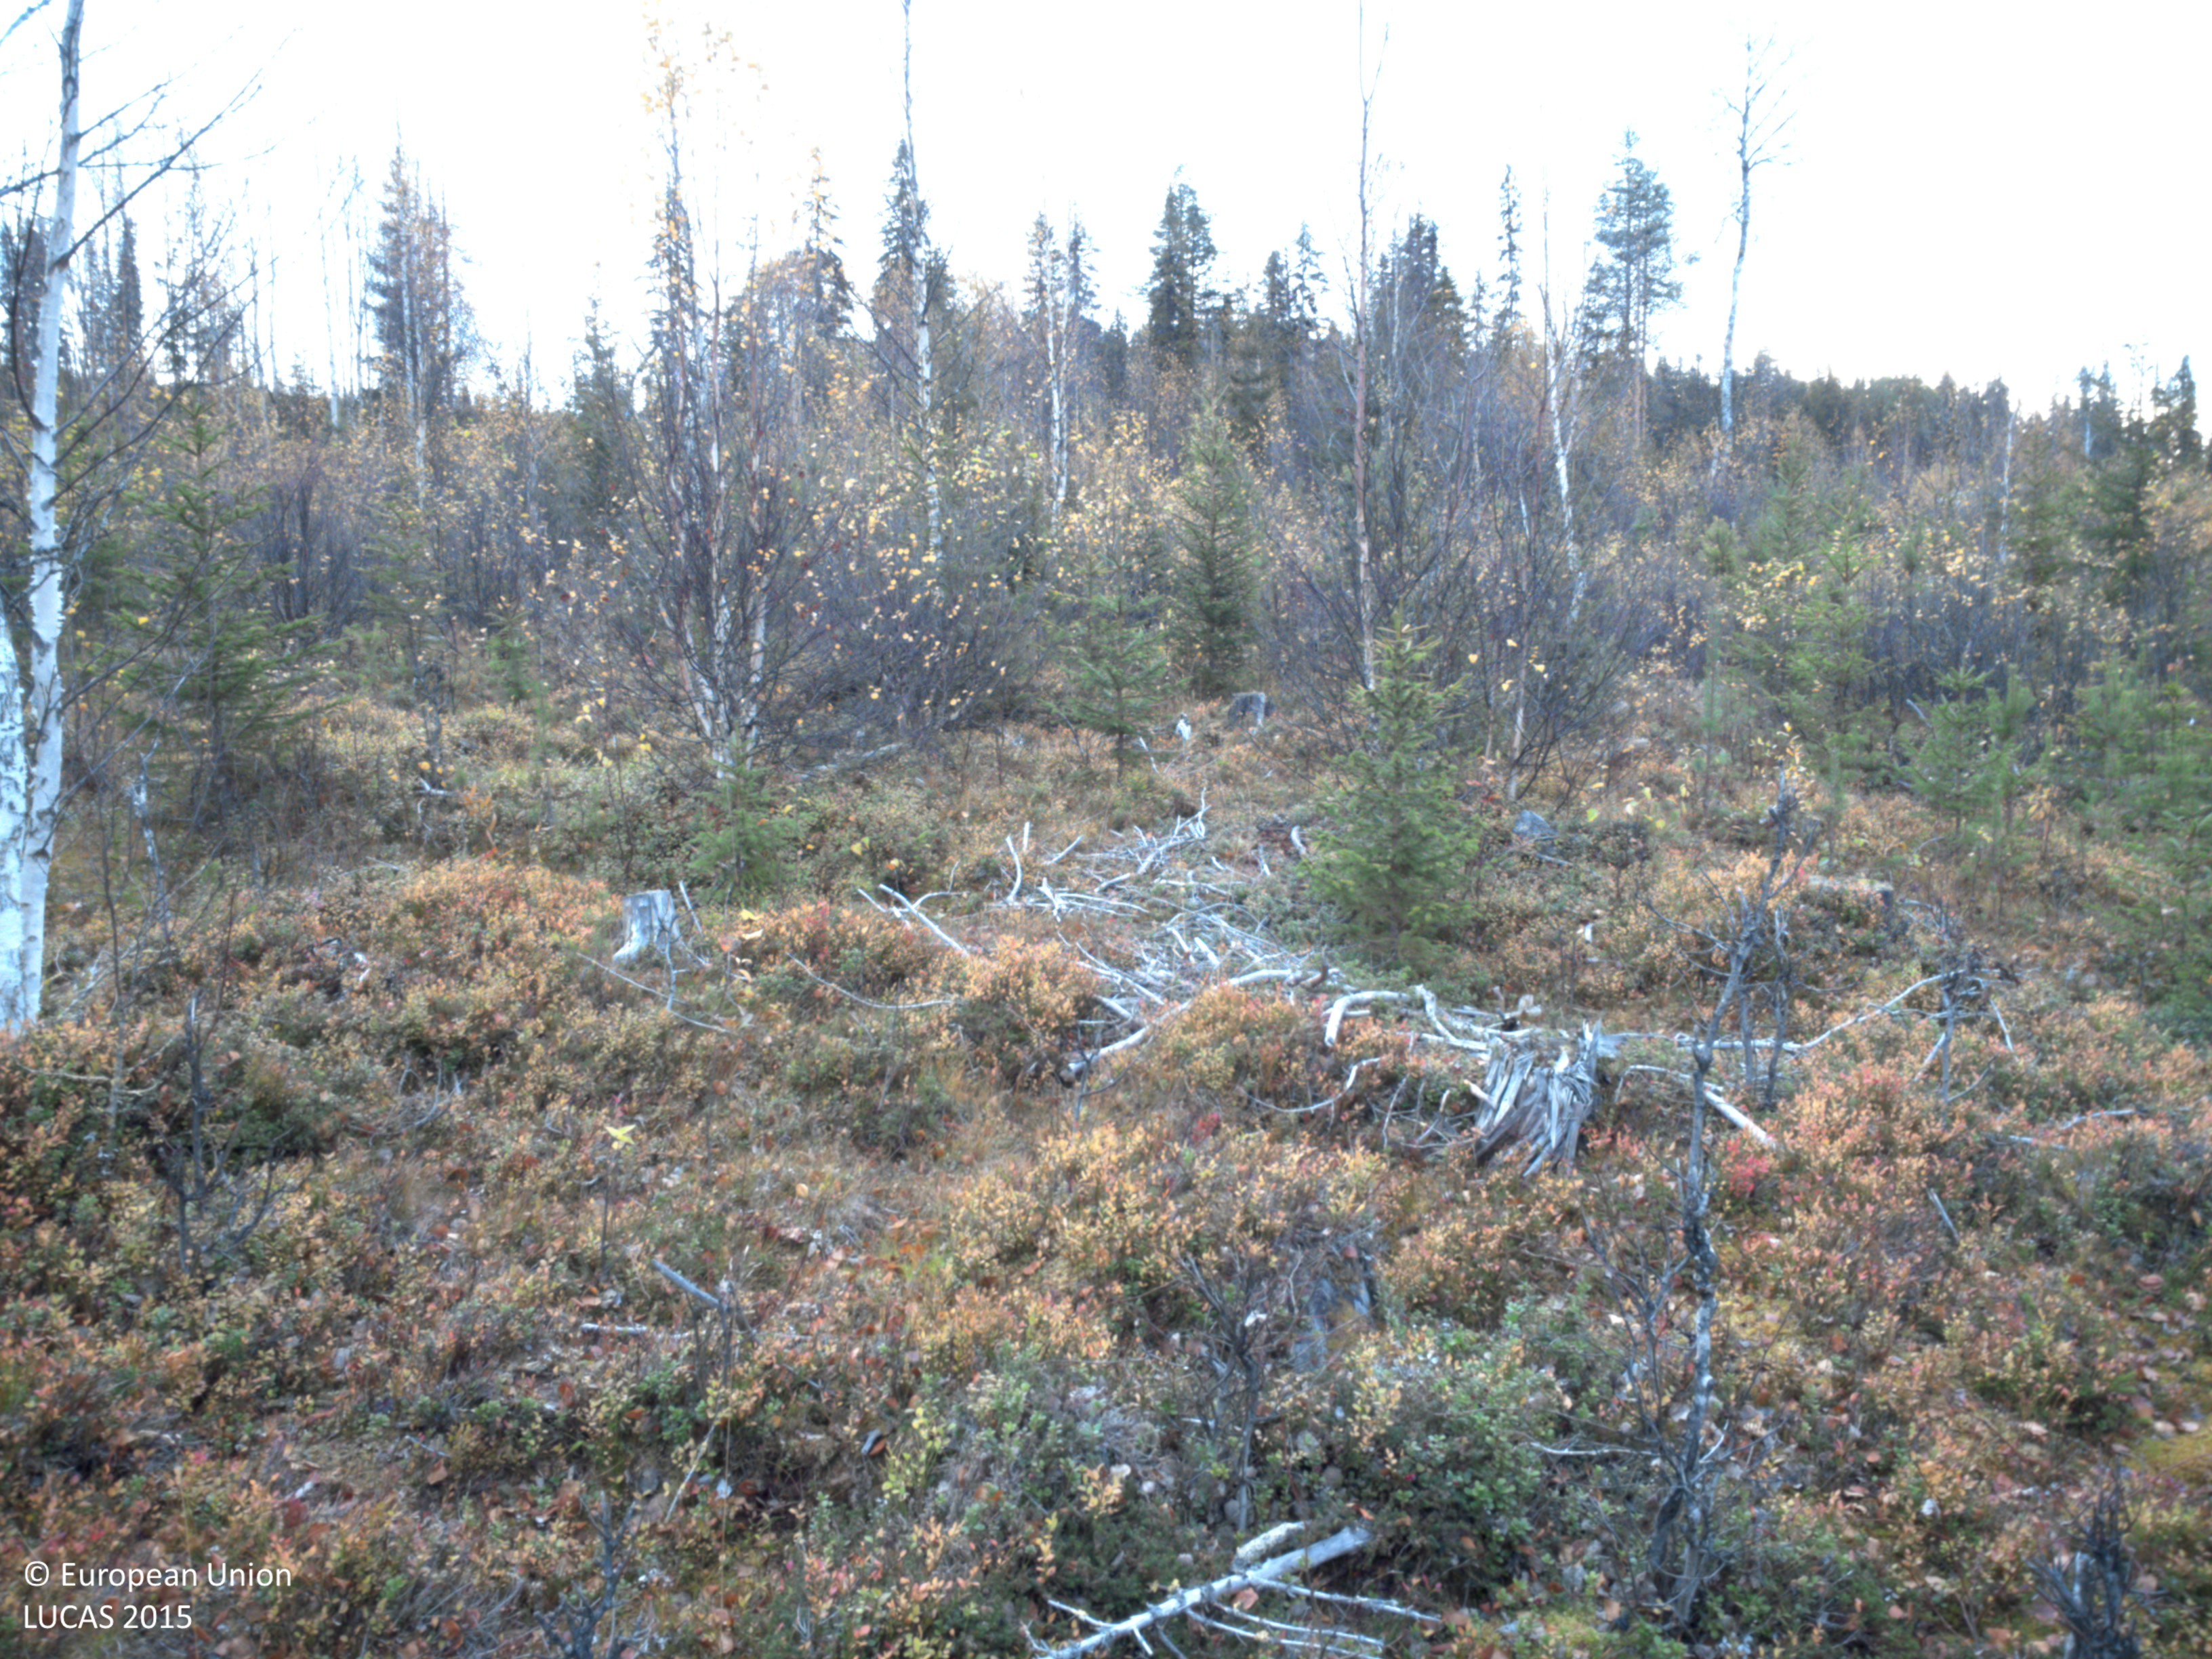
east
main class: Woodland
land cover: Spruce dominated mixed woodland
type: boreal forest
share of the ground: 25 - 50 %
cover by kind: shrubs 50 %, coniferous forest trees 30 %, broadleaved forest trees 10 %, herbaceous plants 5 %, lichens and mosses 5 %
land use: Forestry
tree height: < 5 m
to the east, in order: Spruce dominated mixed woodland; Paved roads, cycling and walking lanes; Ditches and canals; Spruce dominated mixed woodland; Broadleaved woodland; Spruce dominated mixed woodland
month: October
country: SE
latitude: 64.6945
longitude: 18.2066
